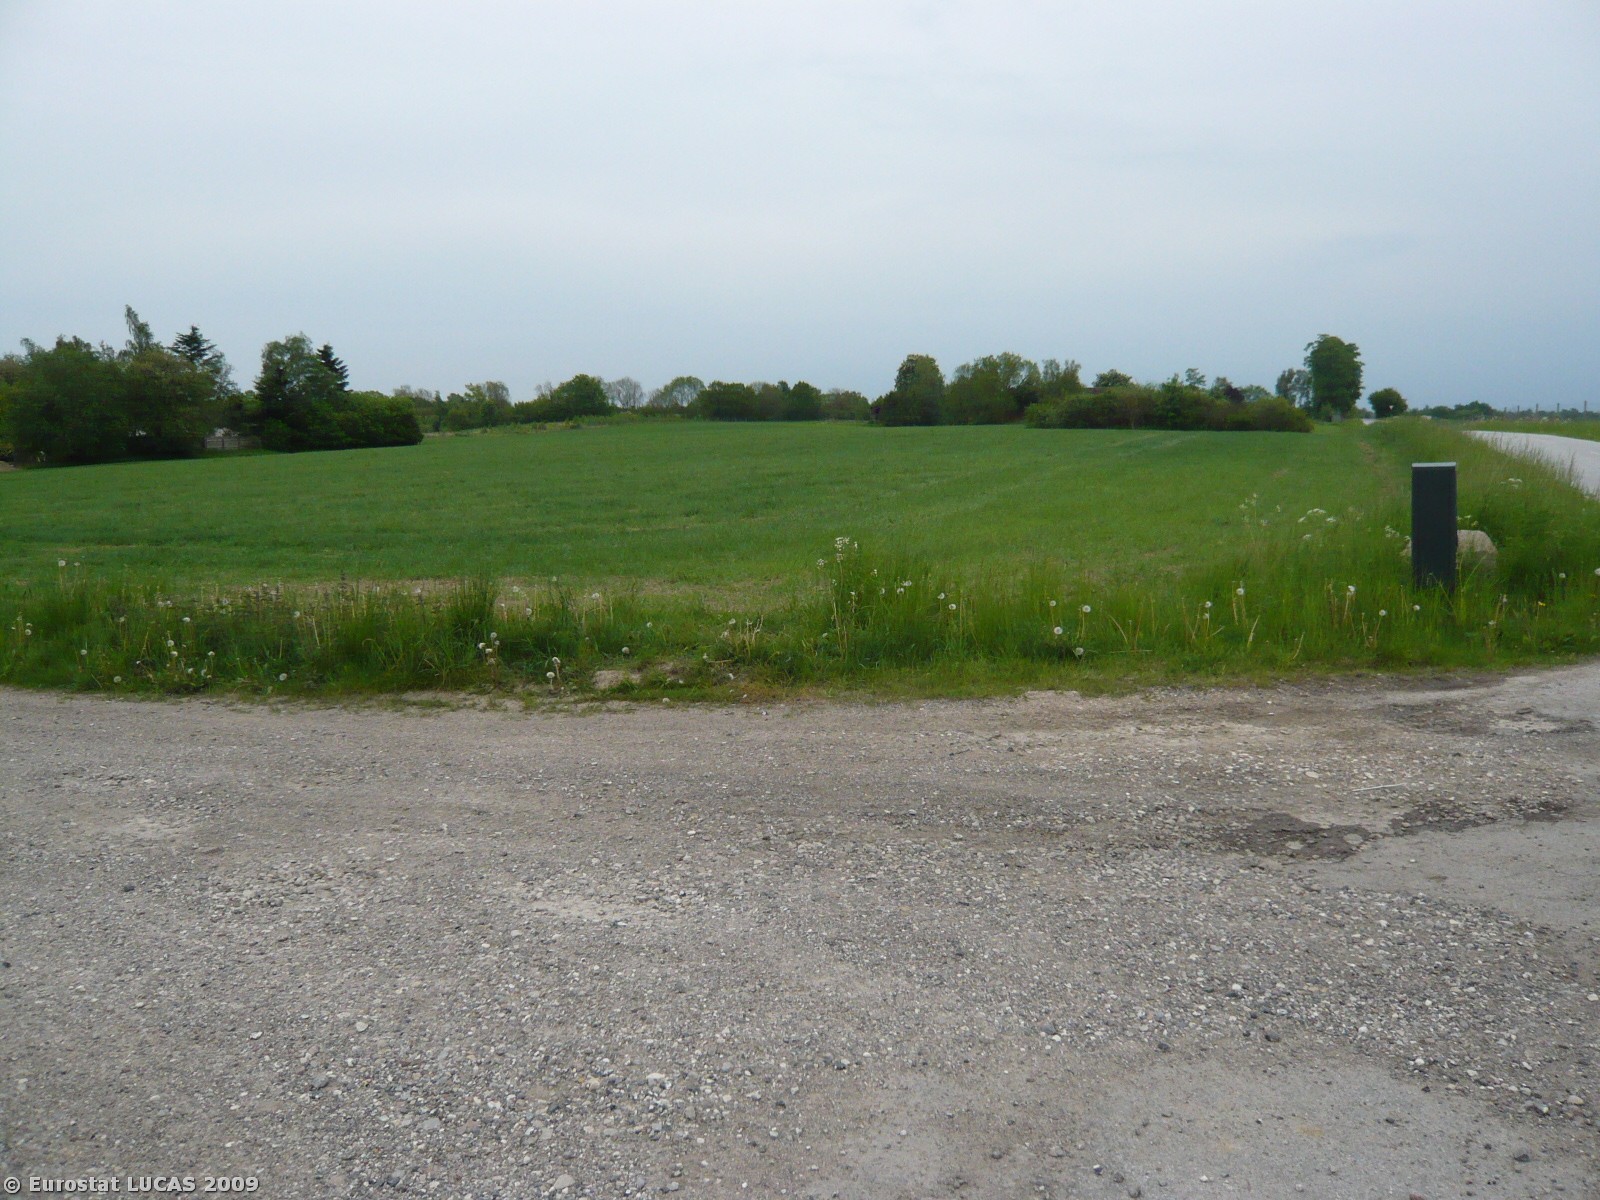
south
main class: Shrubland
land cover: Shrubland with sparse tree cover
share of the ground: 25 - 50 %
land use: Agriculture (excluding fallow land and kitchen gardens)
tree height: > 5 m
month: May
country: DK
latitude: 55.3999
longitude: 11.9407
